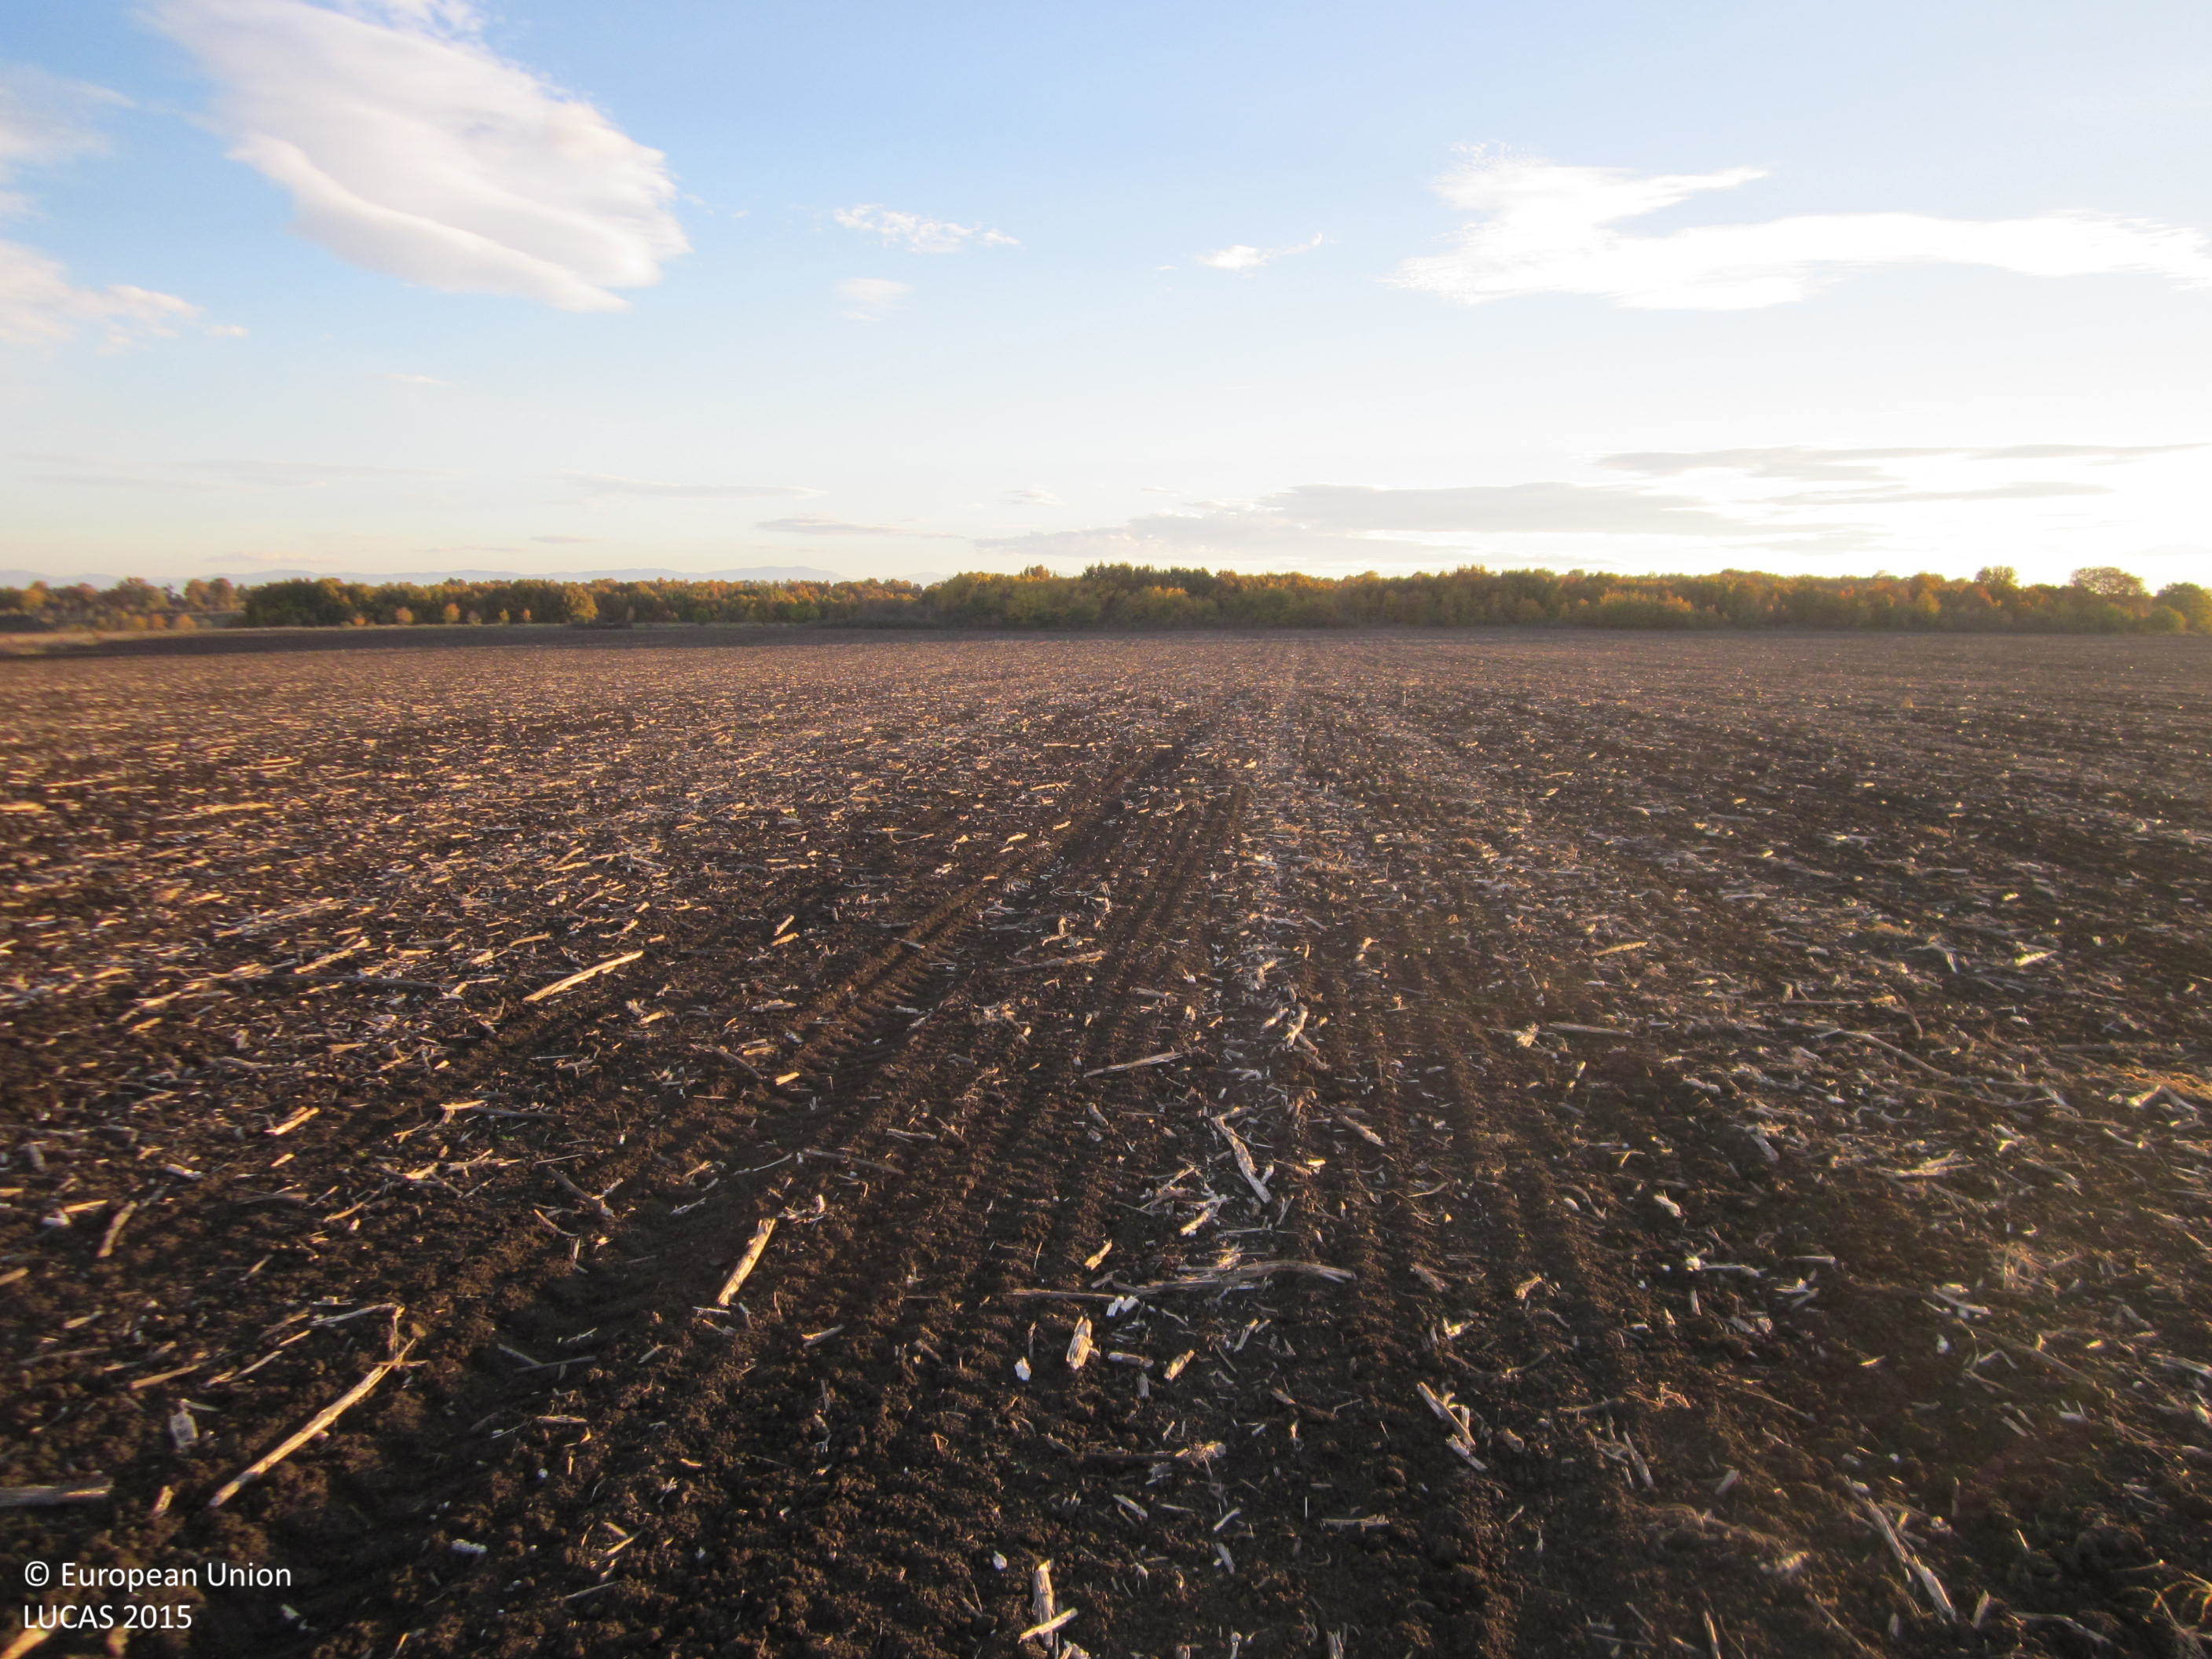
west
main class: Cropland
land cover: Sunflower
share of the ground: < 10 %
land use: Agriculture (excluding fallow land and kitchen gardens)
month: November
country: BG
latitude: 42.3932
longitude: 24.6172
